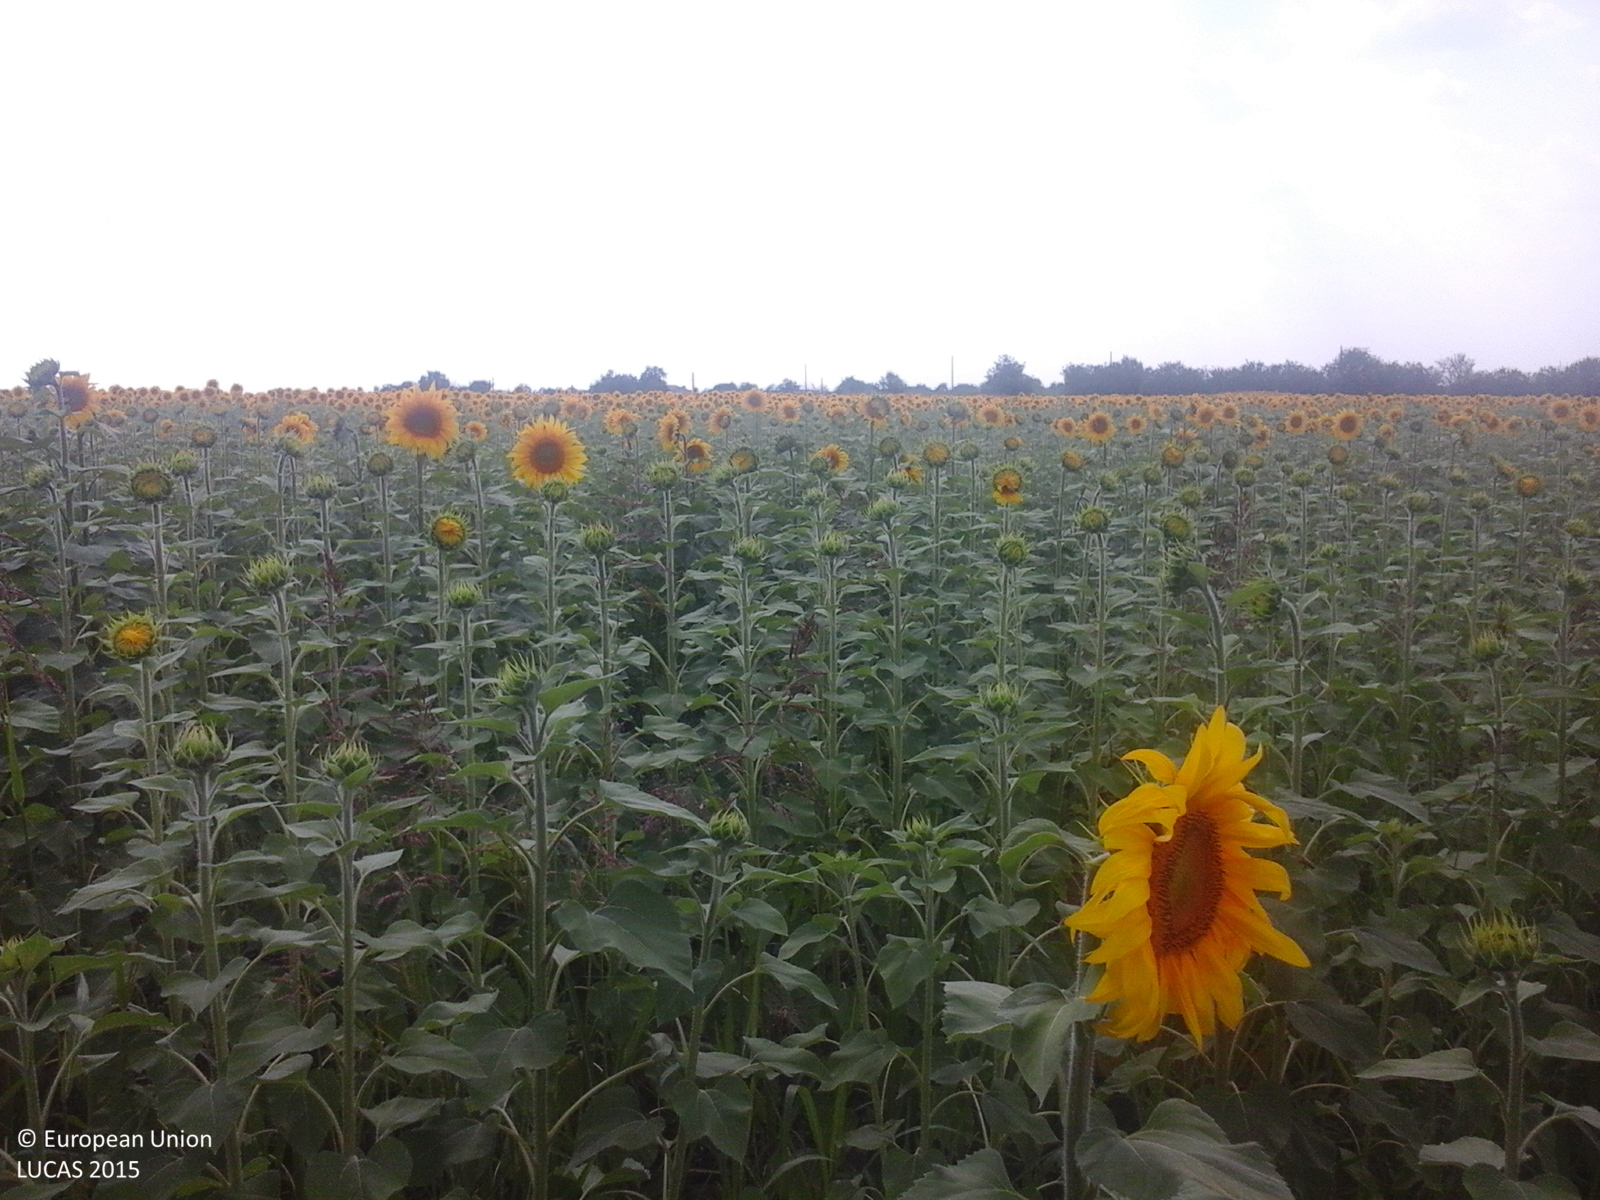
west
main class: Cropland
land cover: Sunflower
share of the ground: > 75 %
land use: Agriculture (excluding fallow land and kitchen gardens)
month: July
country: RO
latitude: 43.8308
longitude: 24.8069
